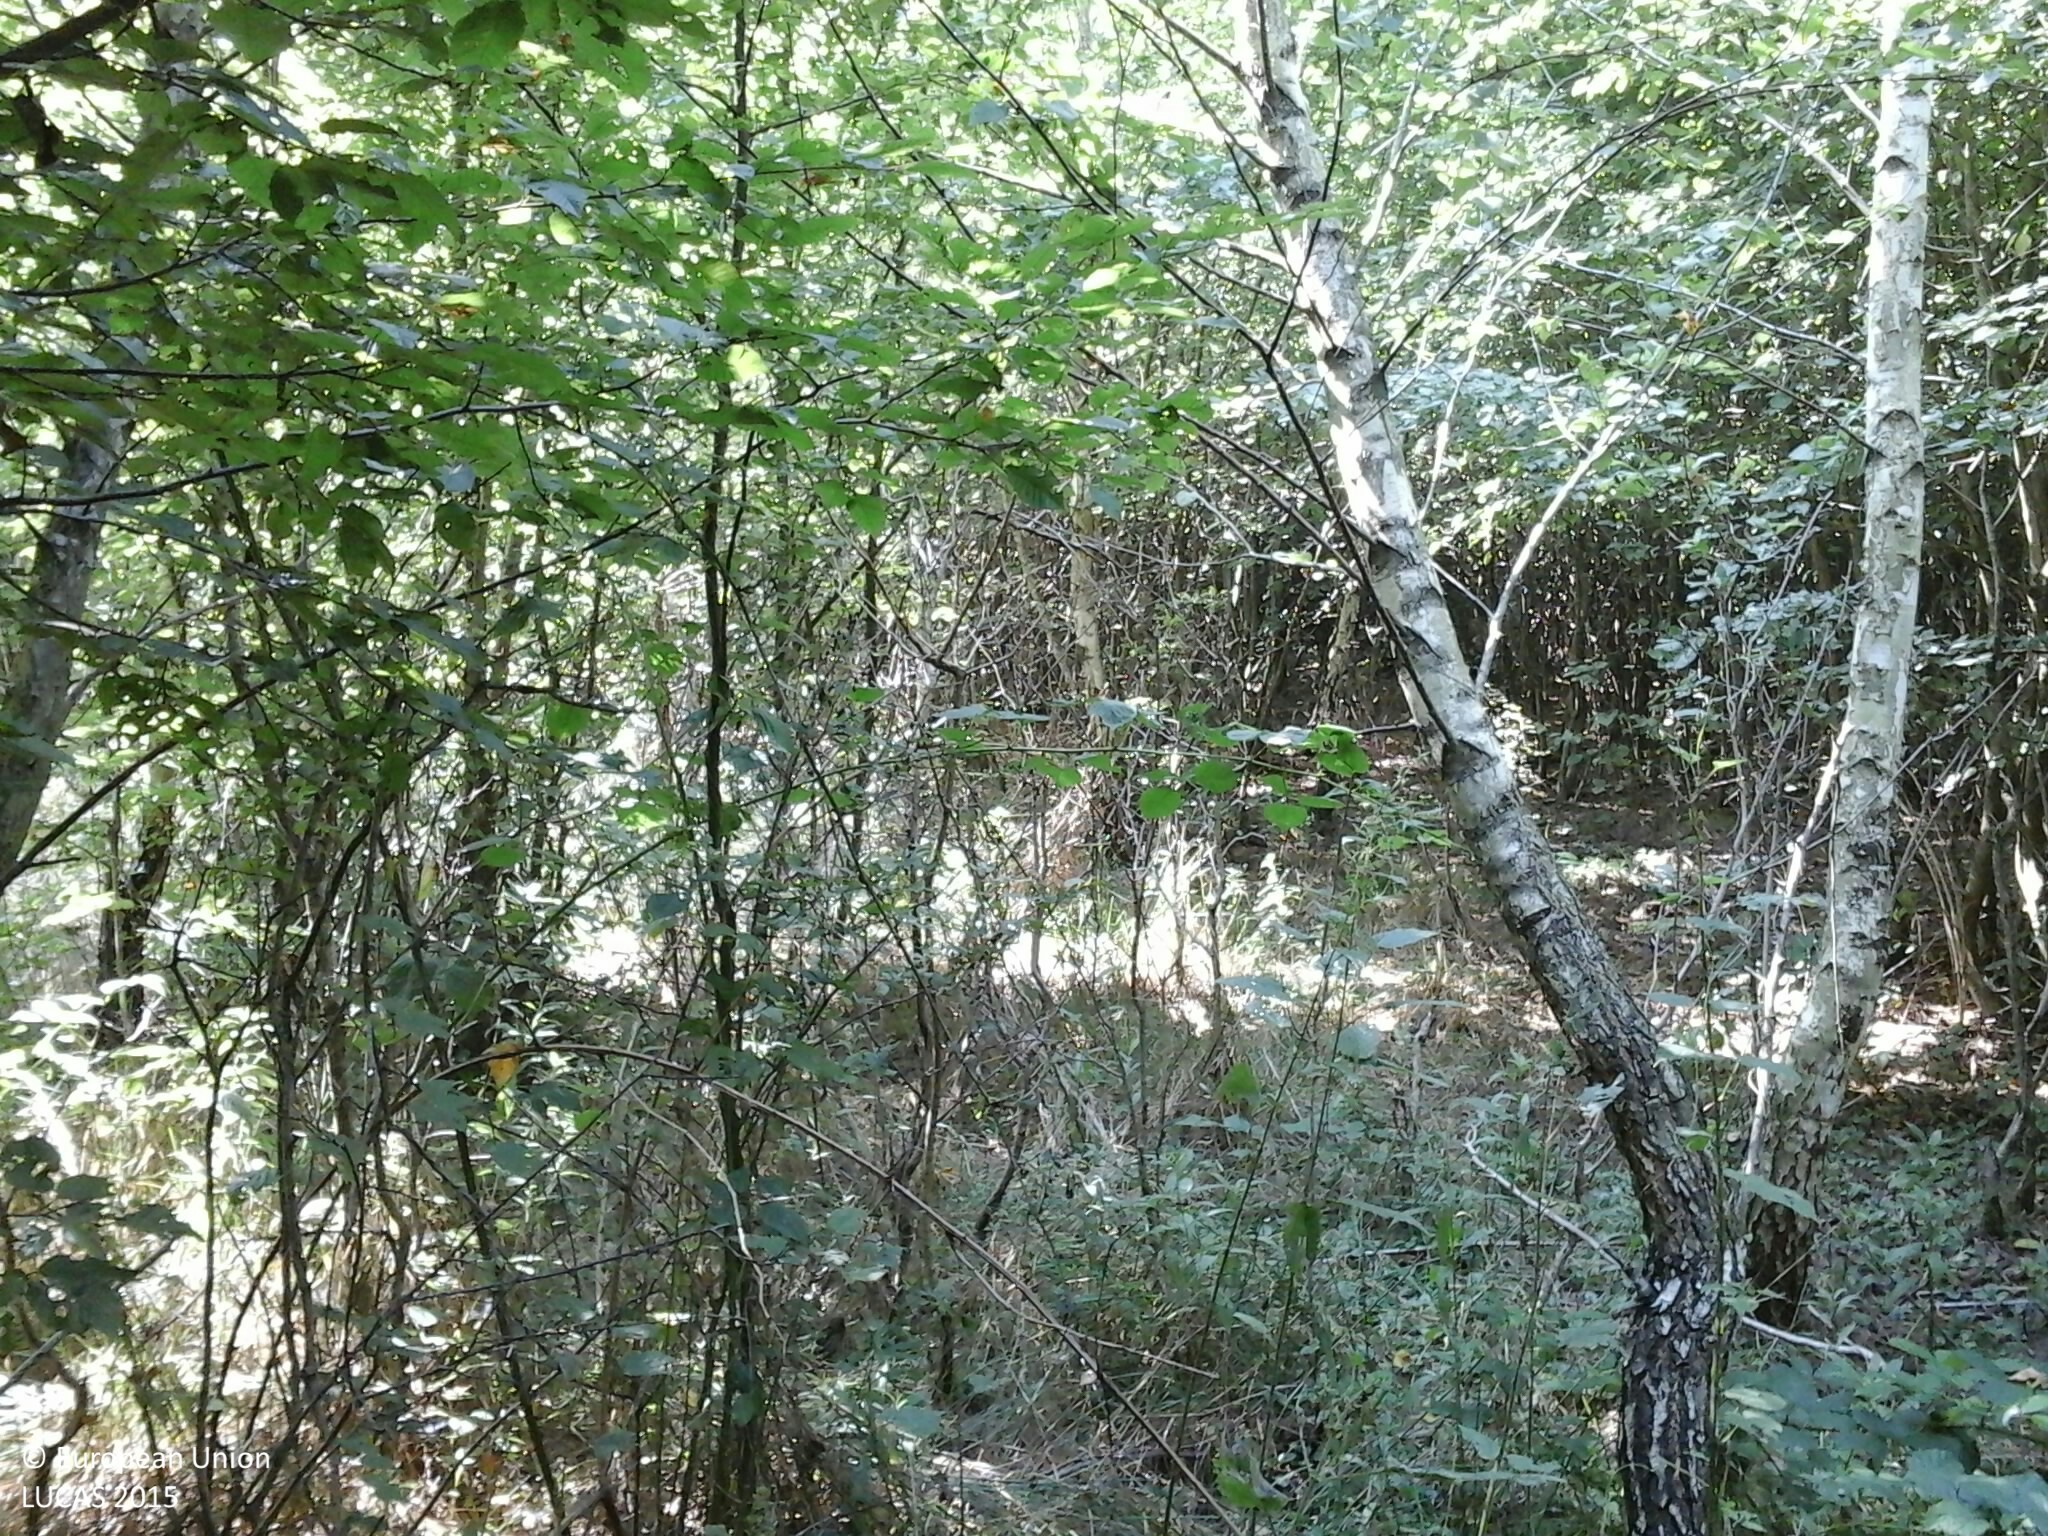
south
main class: Woodland
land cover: Broadleaved woodland
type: beech forest
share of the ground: > 75 %
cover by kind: broadleaved forest trees 80 %, shrubs 10 %, herbaceous plants 10 %
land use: Forestry
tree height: > 5 m
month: July
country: HU
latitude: 46.9854
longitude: 16.4842
